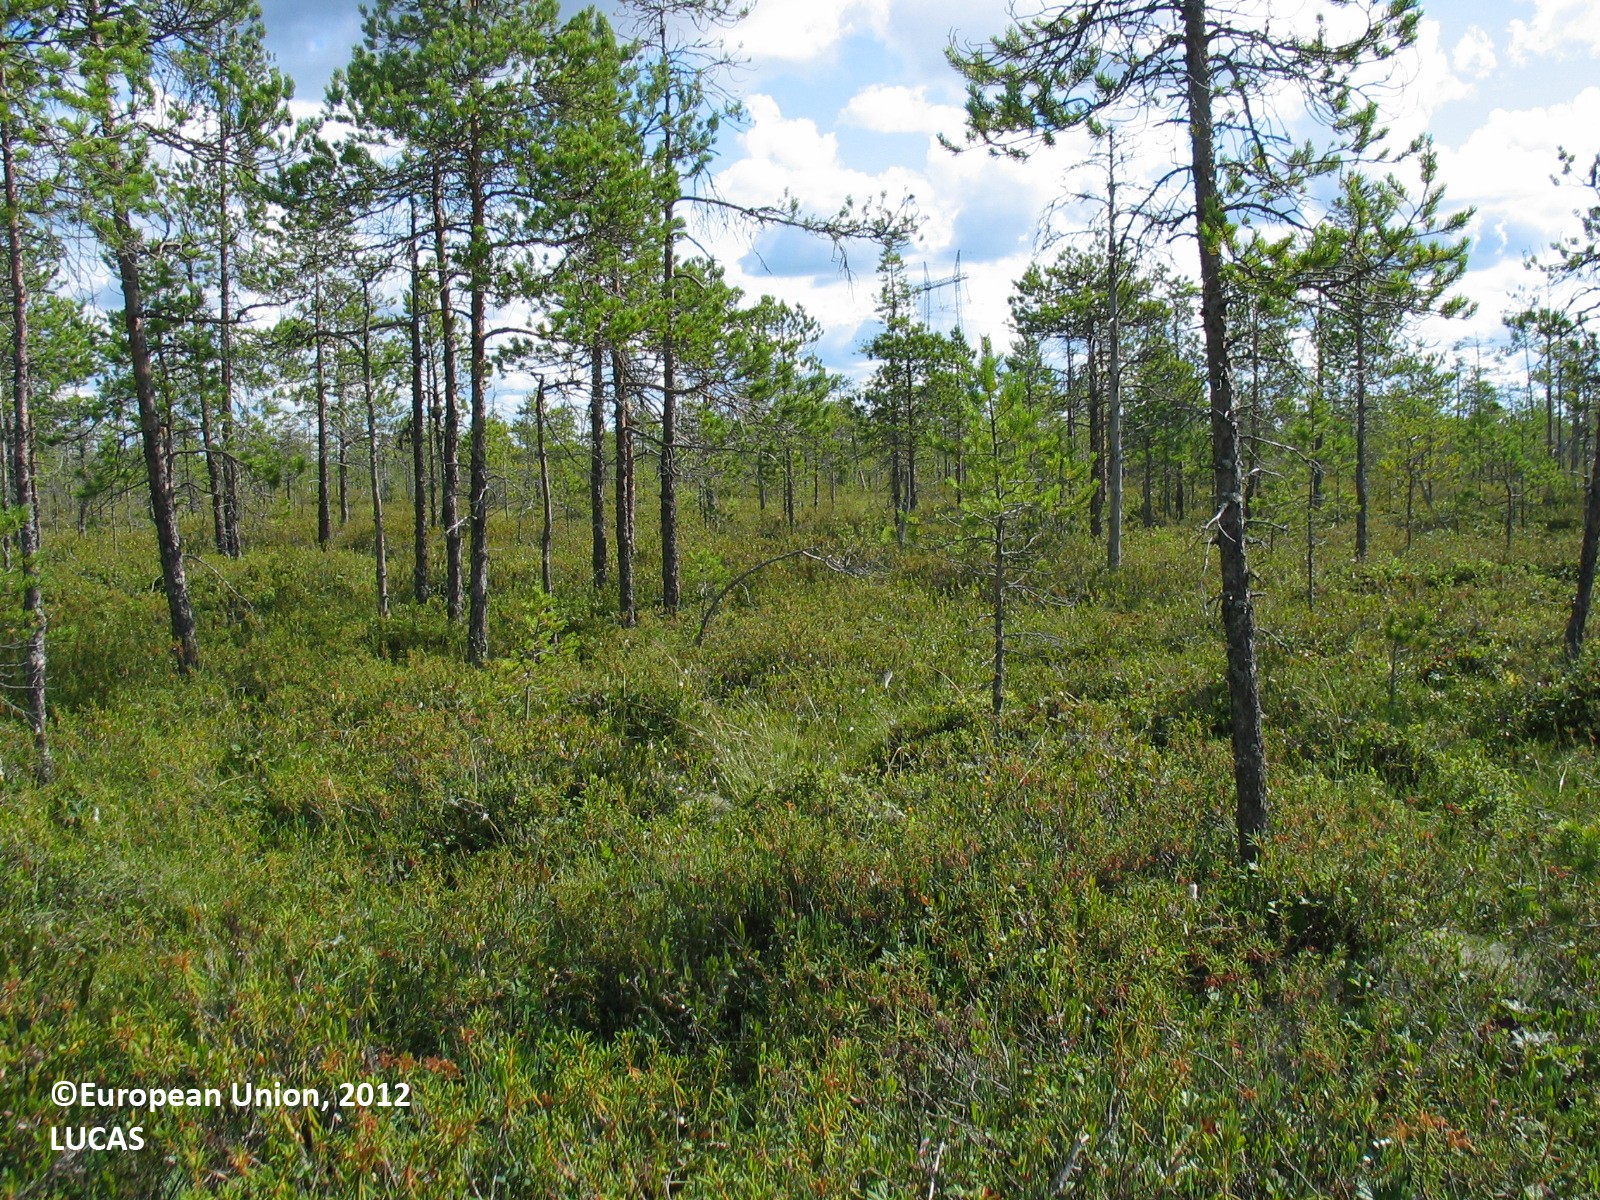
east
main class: Woodland
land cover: Pine dominated coniferous woodland
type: mire and swamp forests
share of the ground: 10 - 25 %
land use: Semi-natural and natural areas not in use
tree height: > 5 m
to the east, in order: Pine dominated coniferous woodland; Peatbogs; Pine dominated coniferous woodland; Peatbogs
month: August
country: FI
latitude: 64.8026
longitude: 26.1643
